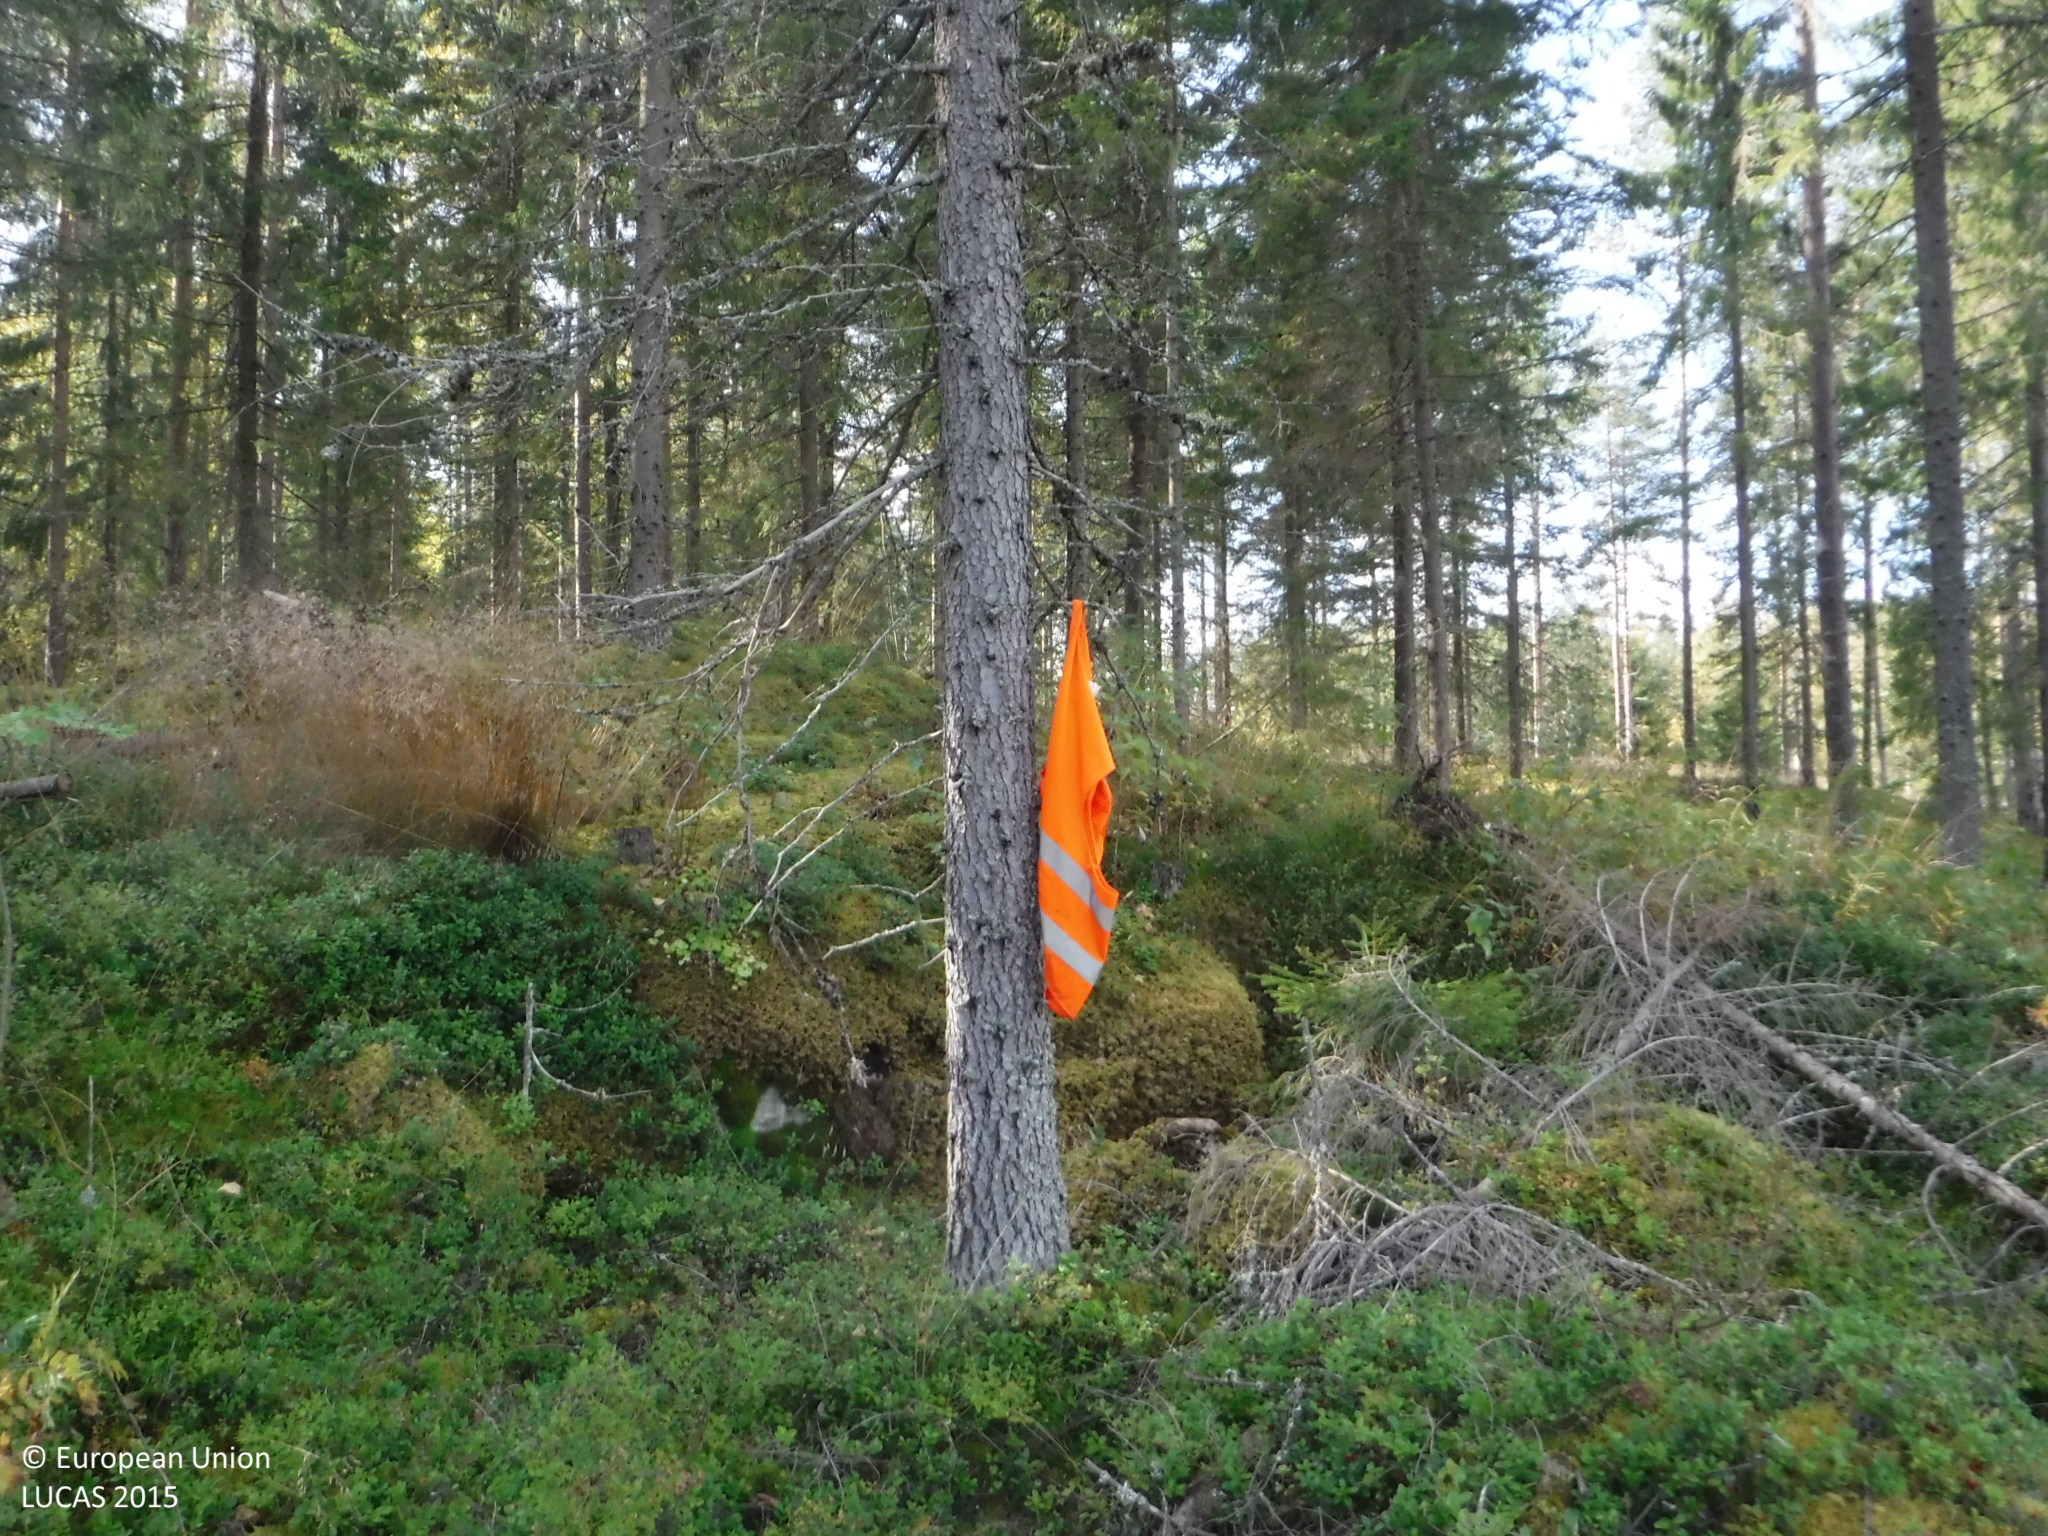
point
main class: Woodland
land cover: Spruce dominated coniferous woodland
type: boreal forest
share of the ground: 25 - 50 %
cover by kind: lichens and mosses 45 %, coniferous forest trees 40 %, shrubs 15 %
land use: Forestry
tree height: > 5 m
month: September
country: FI
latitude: 61.7332
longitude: 22.3825
